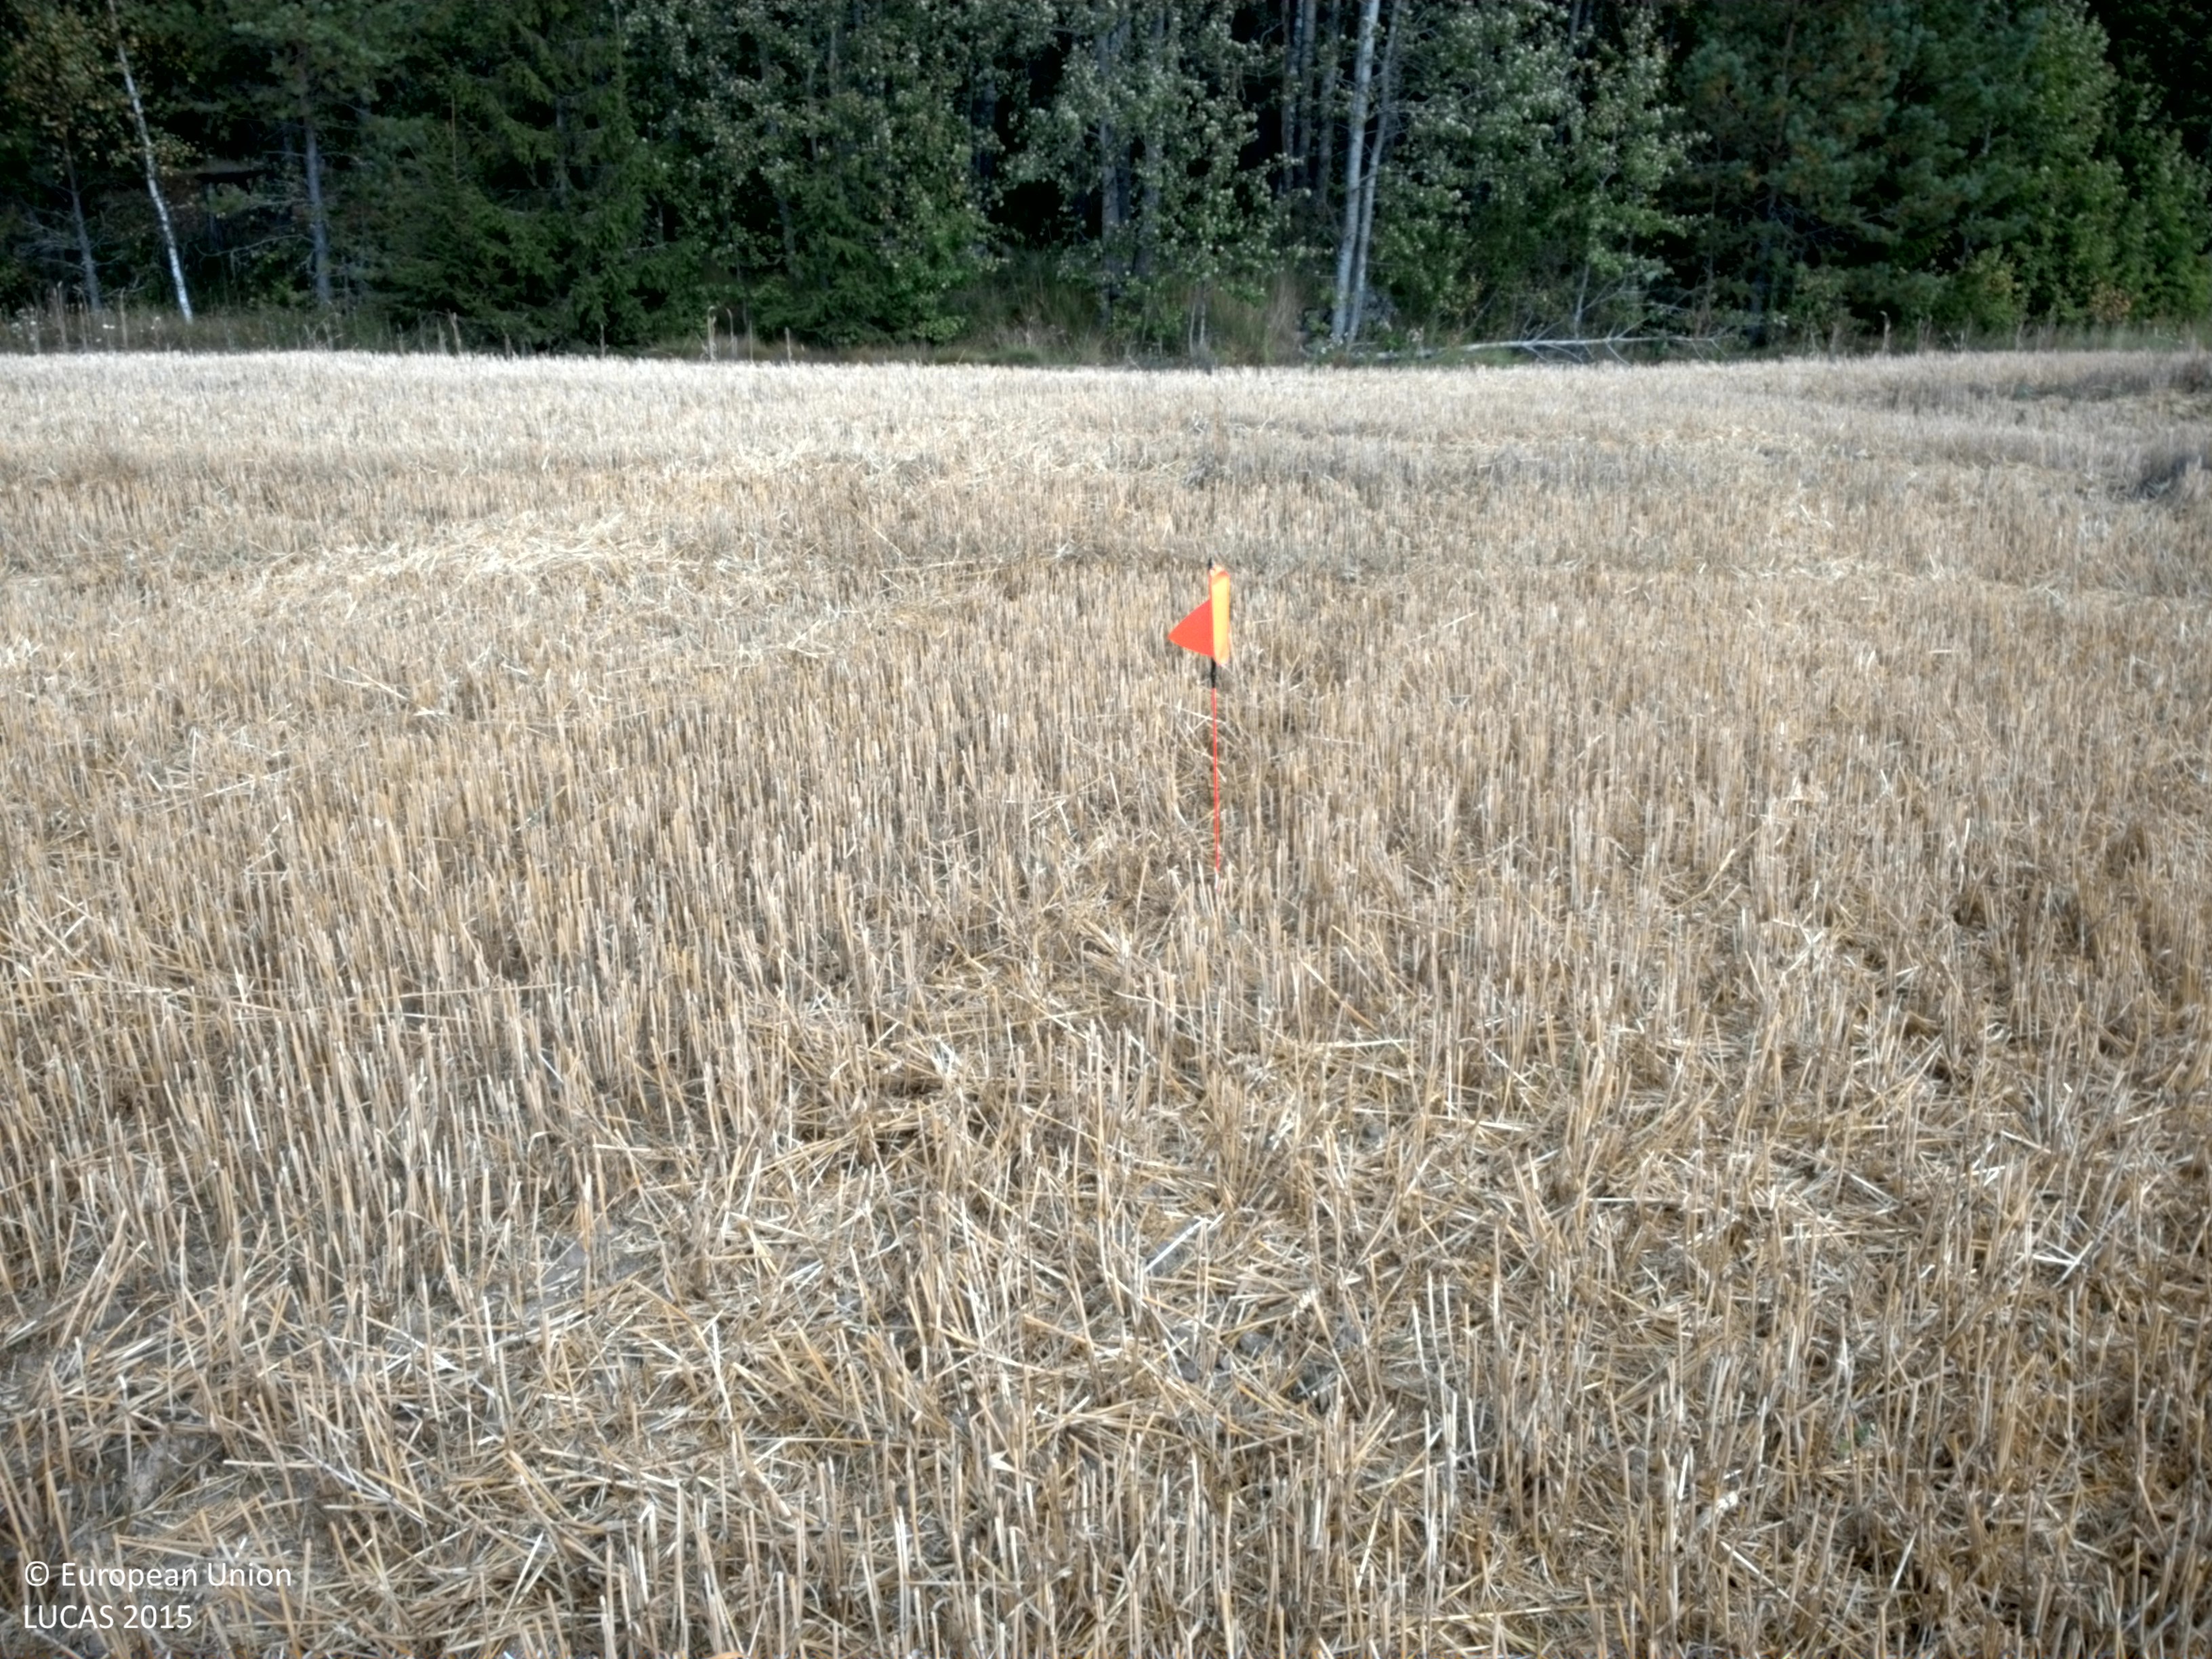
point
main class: Cropland
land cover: Common wheat
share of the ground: > 75 %
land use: Agriculture (excluding fallow land and kitchen gardens)
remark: Harvested field
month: August
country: SE
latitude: 59.6541
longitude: 17.1805
